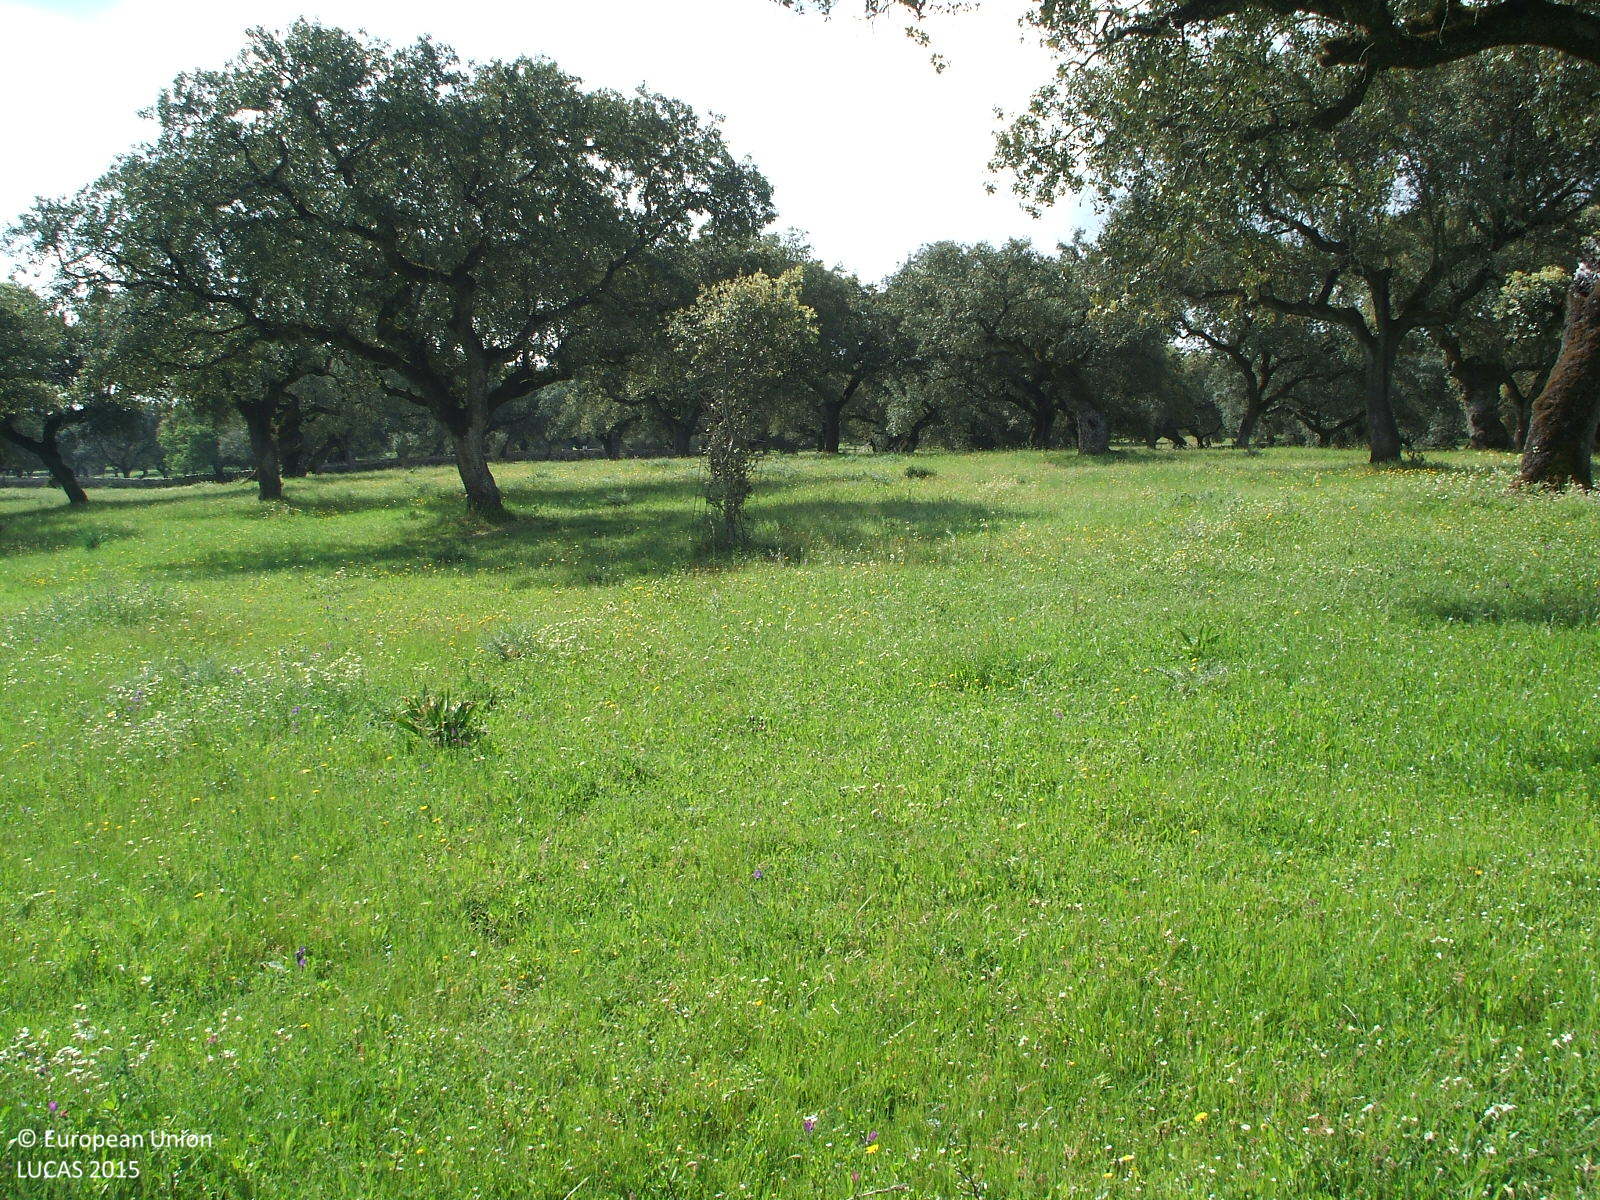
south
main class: Woodland
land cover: Broadleaved woodland
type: broadleaved evergreen forest
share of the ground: 25 - 50 %
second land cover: Grassland without tree/shrub cover
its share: > 75 %
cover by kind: herbaceous plants 75 %, broadleaved forest trees 25 %
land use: Forestry
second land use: Agriculture (excluding fallow land and kitchen gardens)
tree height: > 5 m
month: April
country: ES
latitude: 37.9967
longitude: -6.2669
